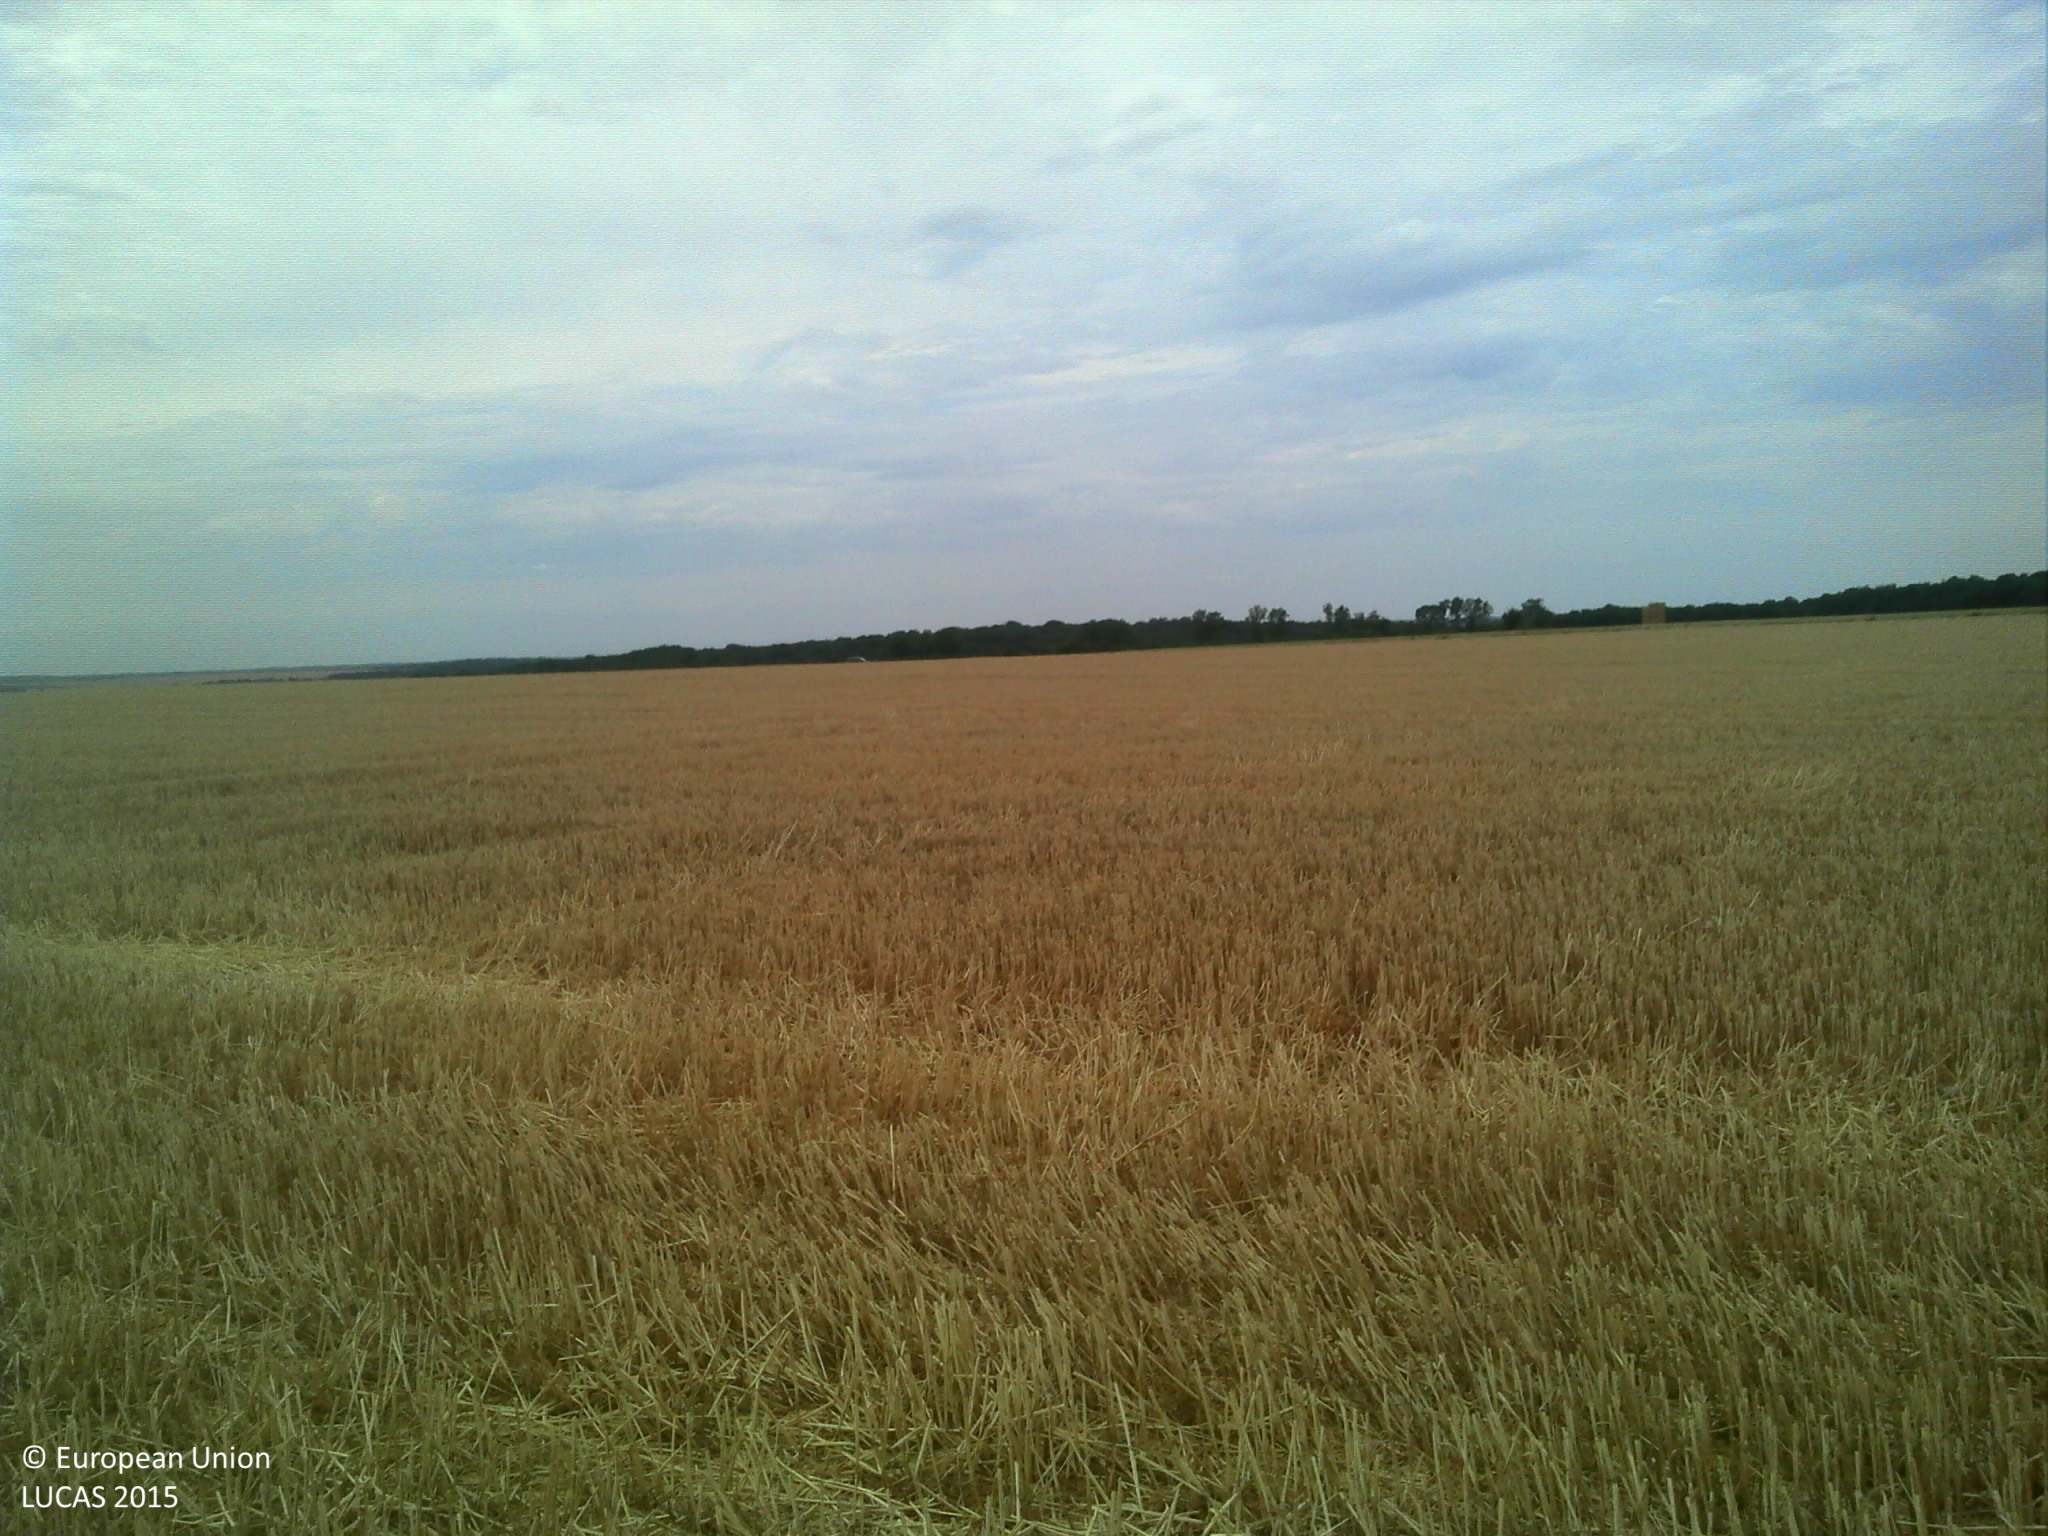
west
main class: Cropland
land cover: Common wheat
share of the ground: 10 - 25 %
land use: Agriculture (excluding fallow land and kitchen gardens)
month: July
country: FR
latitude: 47.9935
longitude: 5.2154
